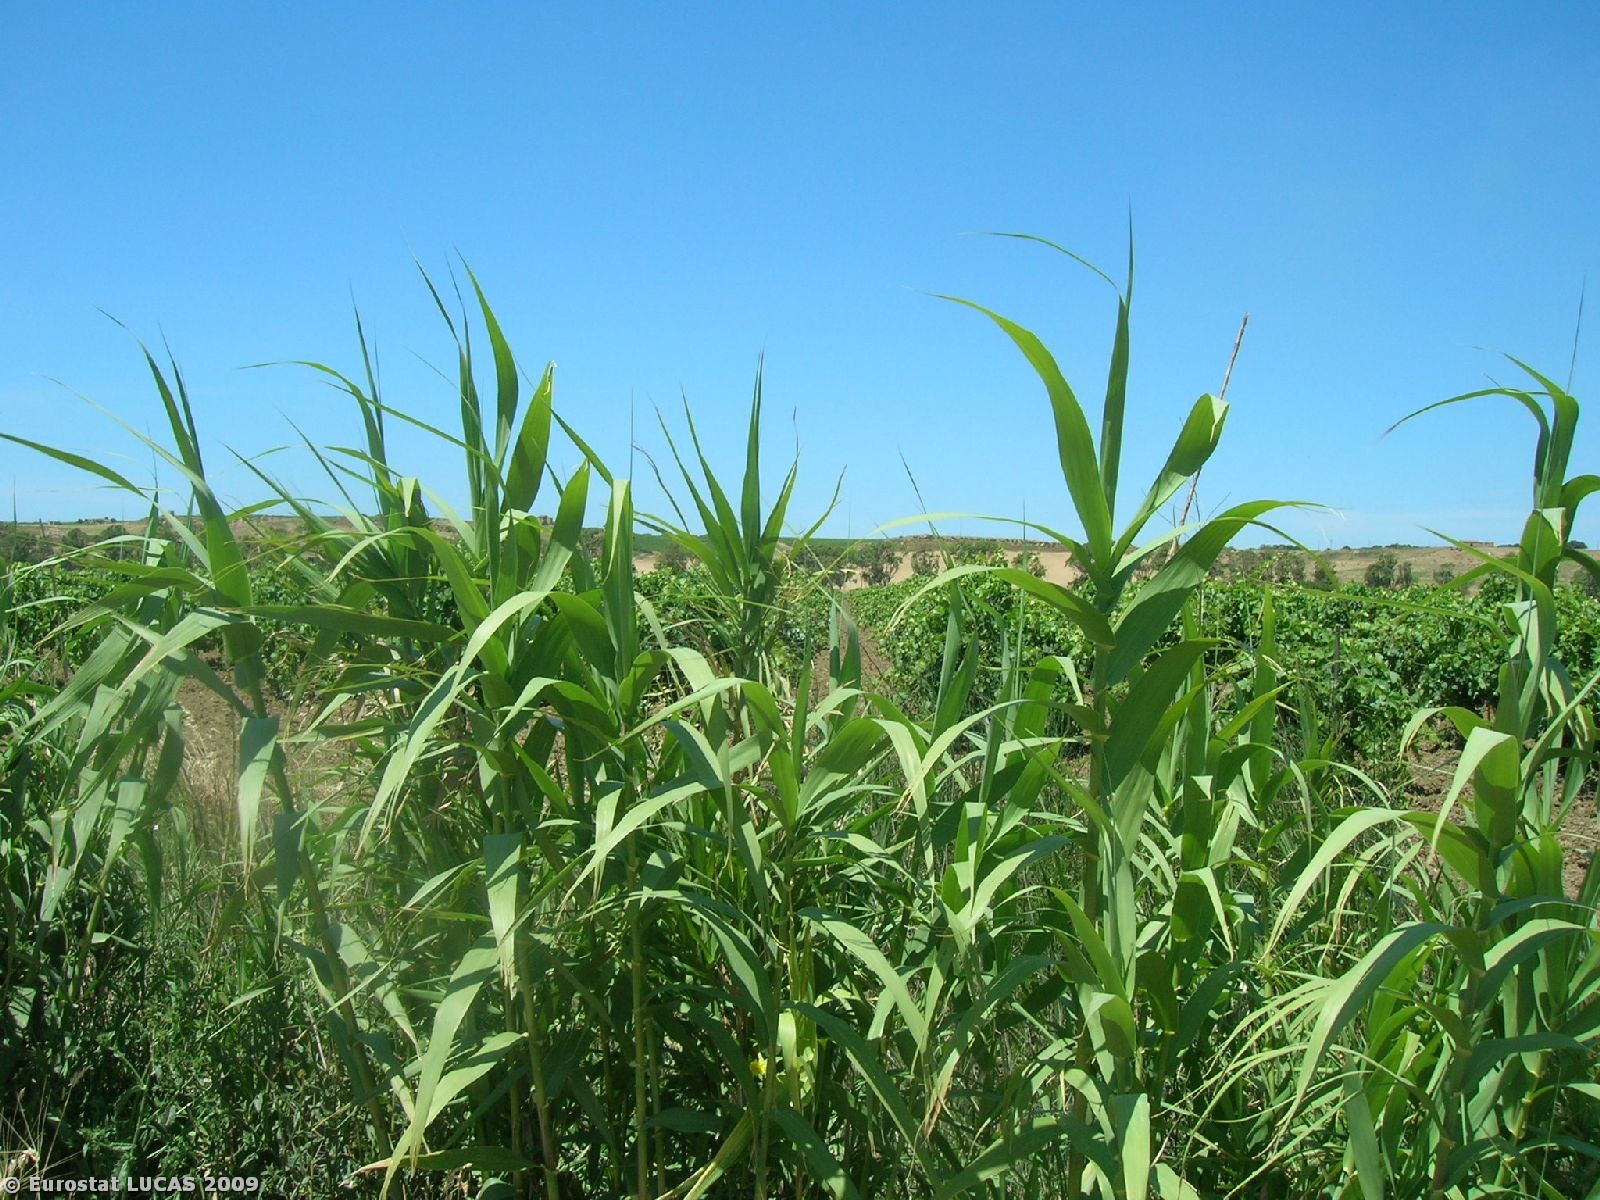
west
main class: Grassland
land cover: Spontaneously vegetated surfaces
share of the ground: > 75 %
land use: Fallow land
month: June
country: IT
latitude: 37.6557
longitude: 12.6661
